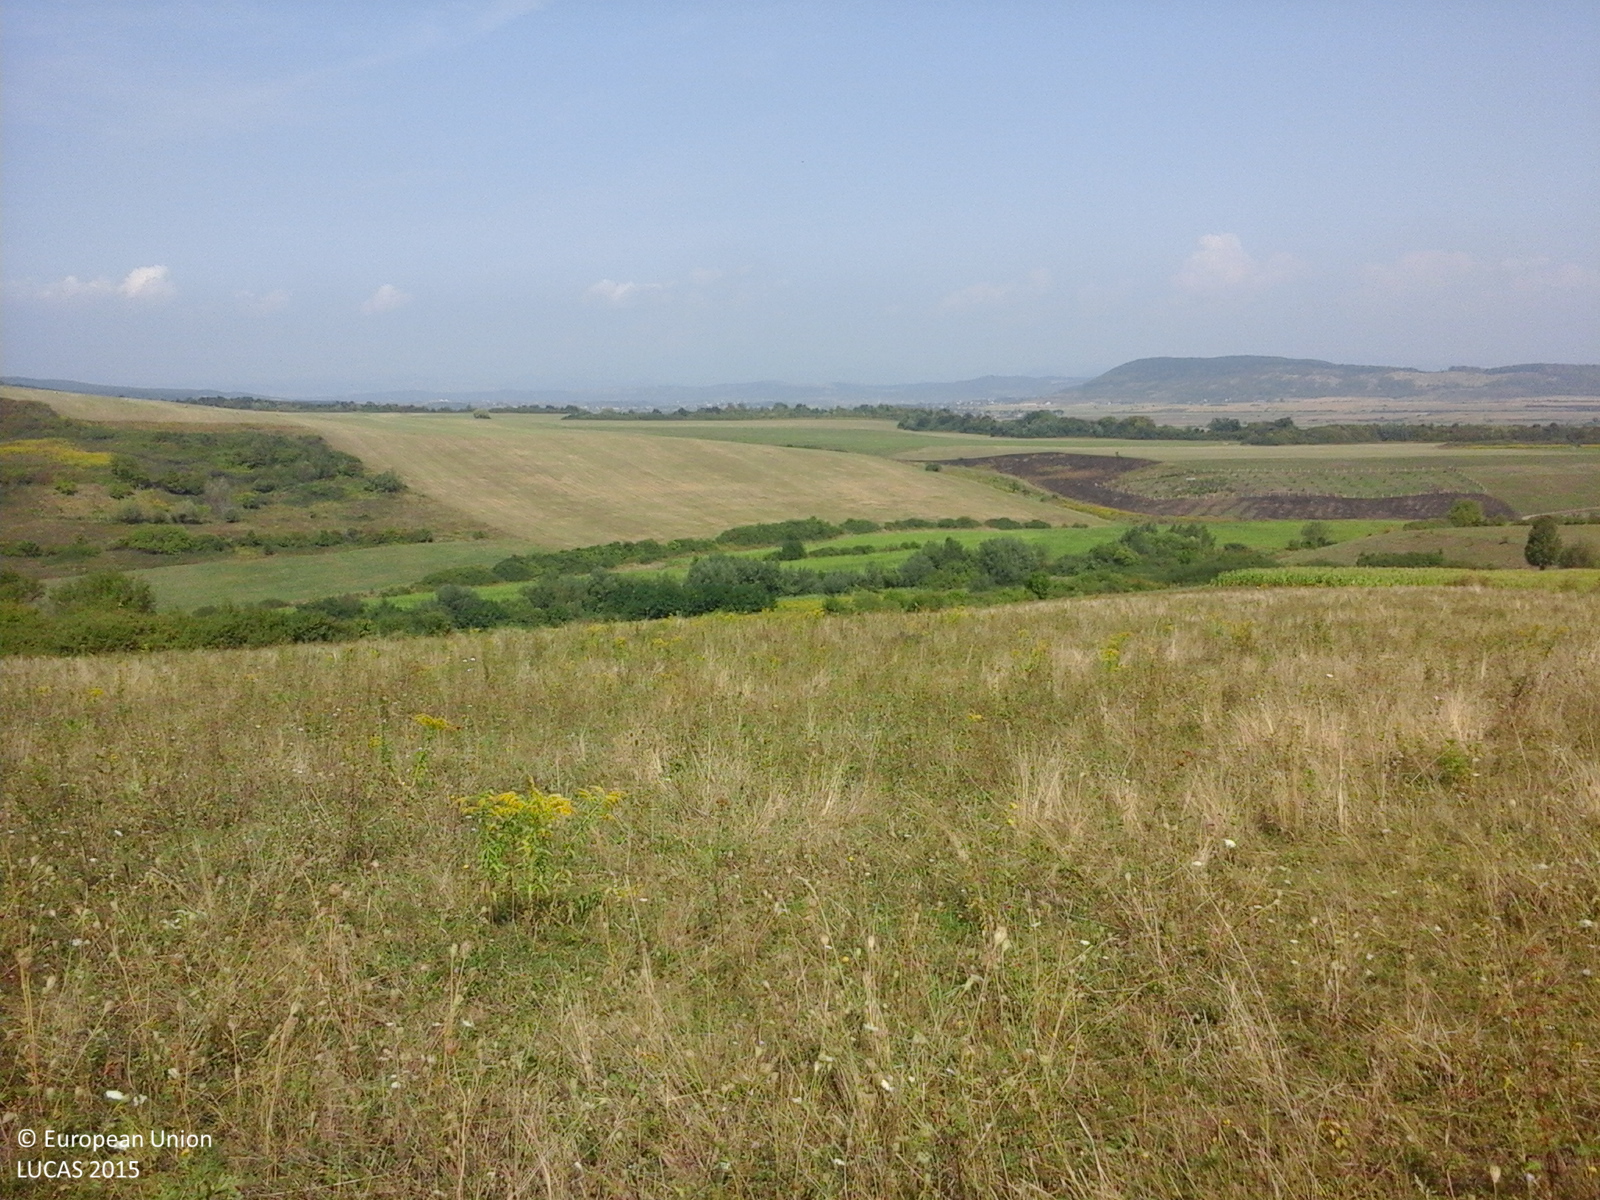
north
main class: Grassland
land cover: Spontaneously vegetated surfaces
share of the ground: > 75 %
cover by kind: herbaceous plants 100 %
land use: Fallow land
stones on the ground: < 10 %
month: September
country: RO
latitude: 47.0843
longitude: 24.2990
